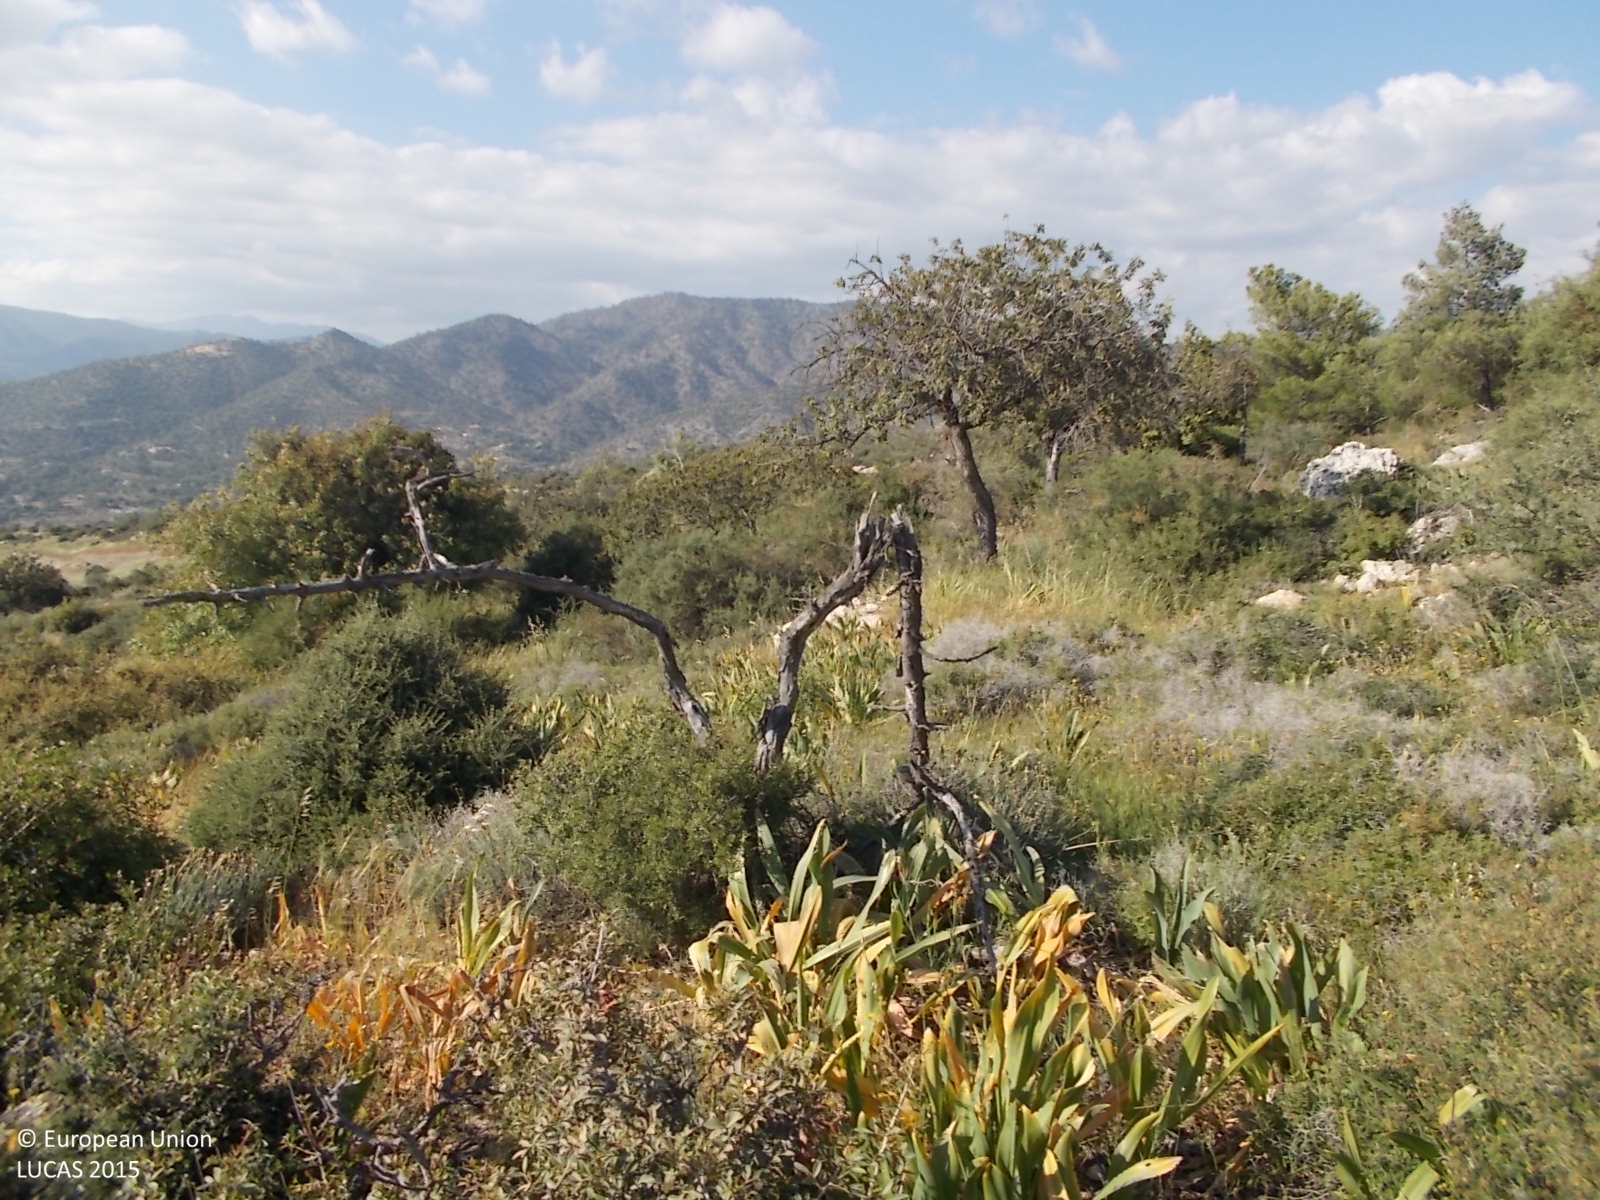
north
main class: Shrubland
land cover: Shrubland with sparse tree cover
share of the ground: > 75 %
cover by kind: shrubs 90 %, broadleaved forest trees 5 %, consolidated bare surface 5 %
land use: Semi-natural and natural areas not in use
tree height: < 5 m
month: April
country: CY
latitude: 34.7447
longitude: 33.1190
